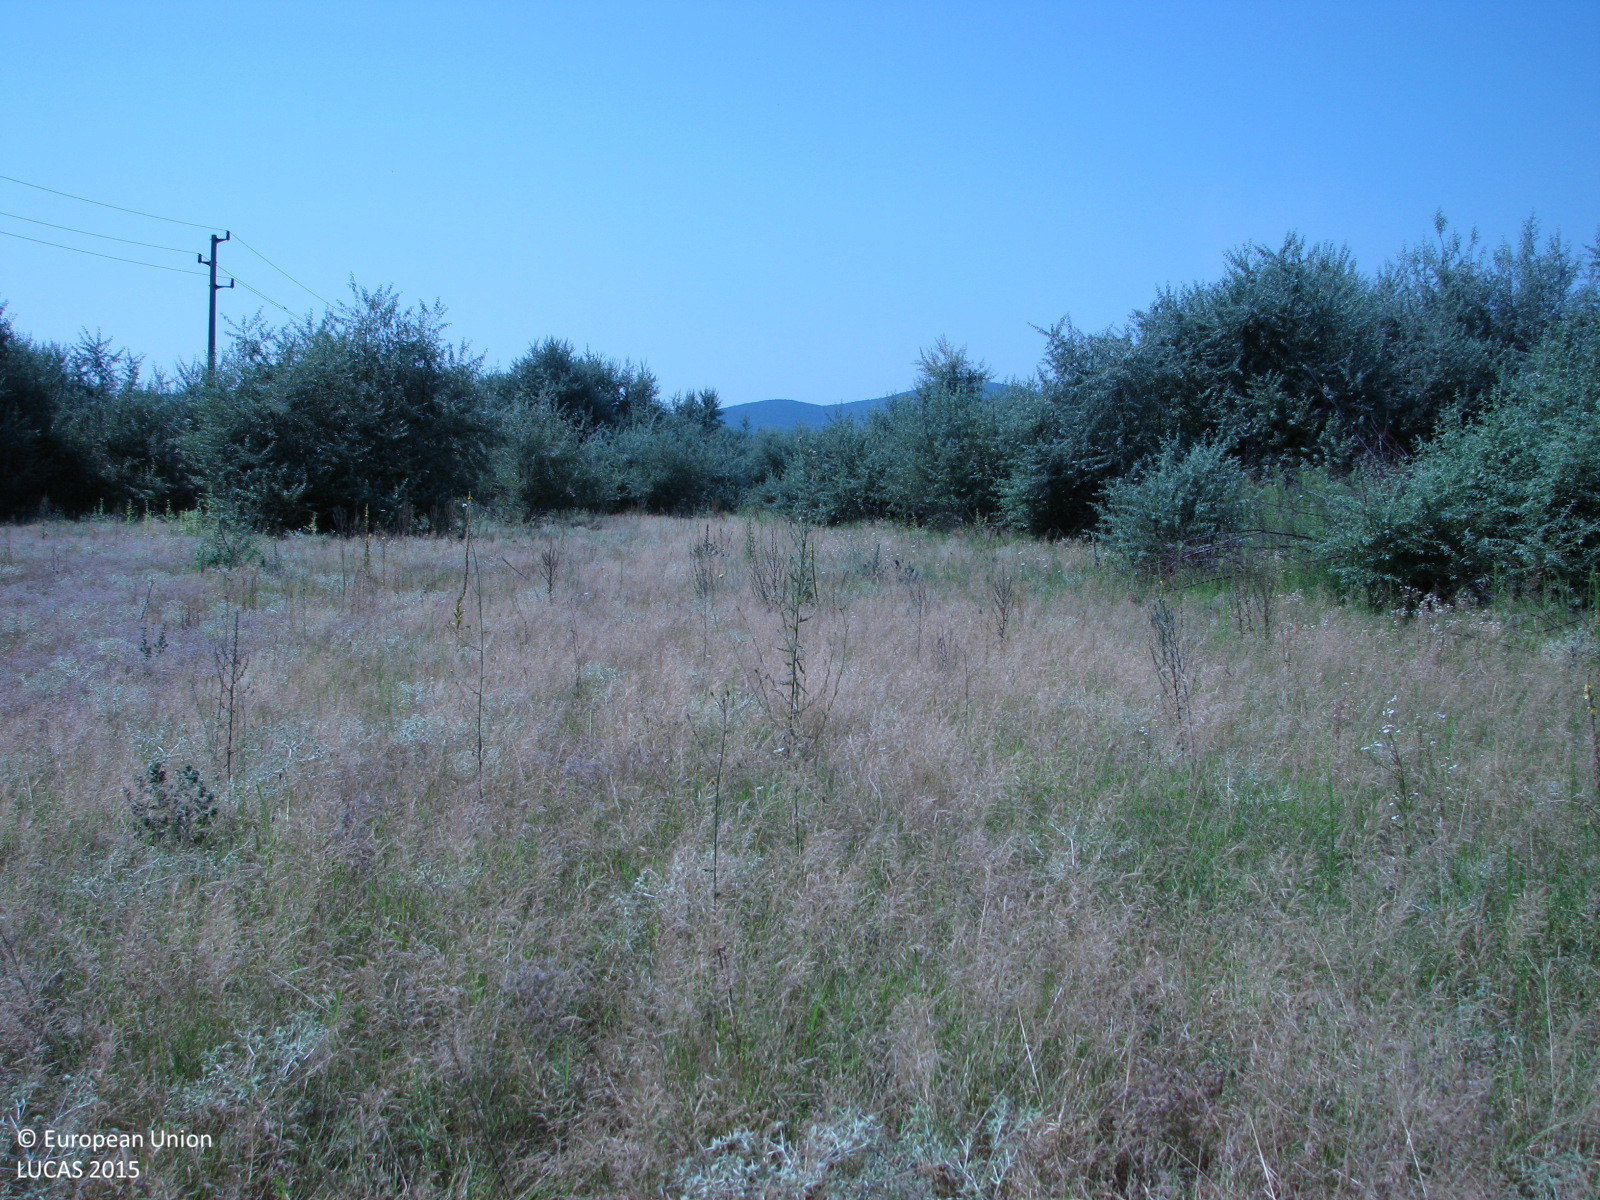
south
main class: Grassland
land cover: Grassland with sparse tree/shrub cover
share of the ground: > 75 %
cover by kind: herbaceous plants 90 %, broadleaved forest trees 5 %, shrubs 5 %
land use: Abandoned areas
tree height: < 5 m
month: July
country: BG
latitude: 42.6389
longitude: 26.1225
